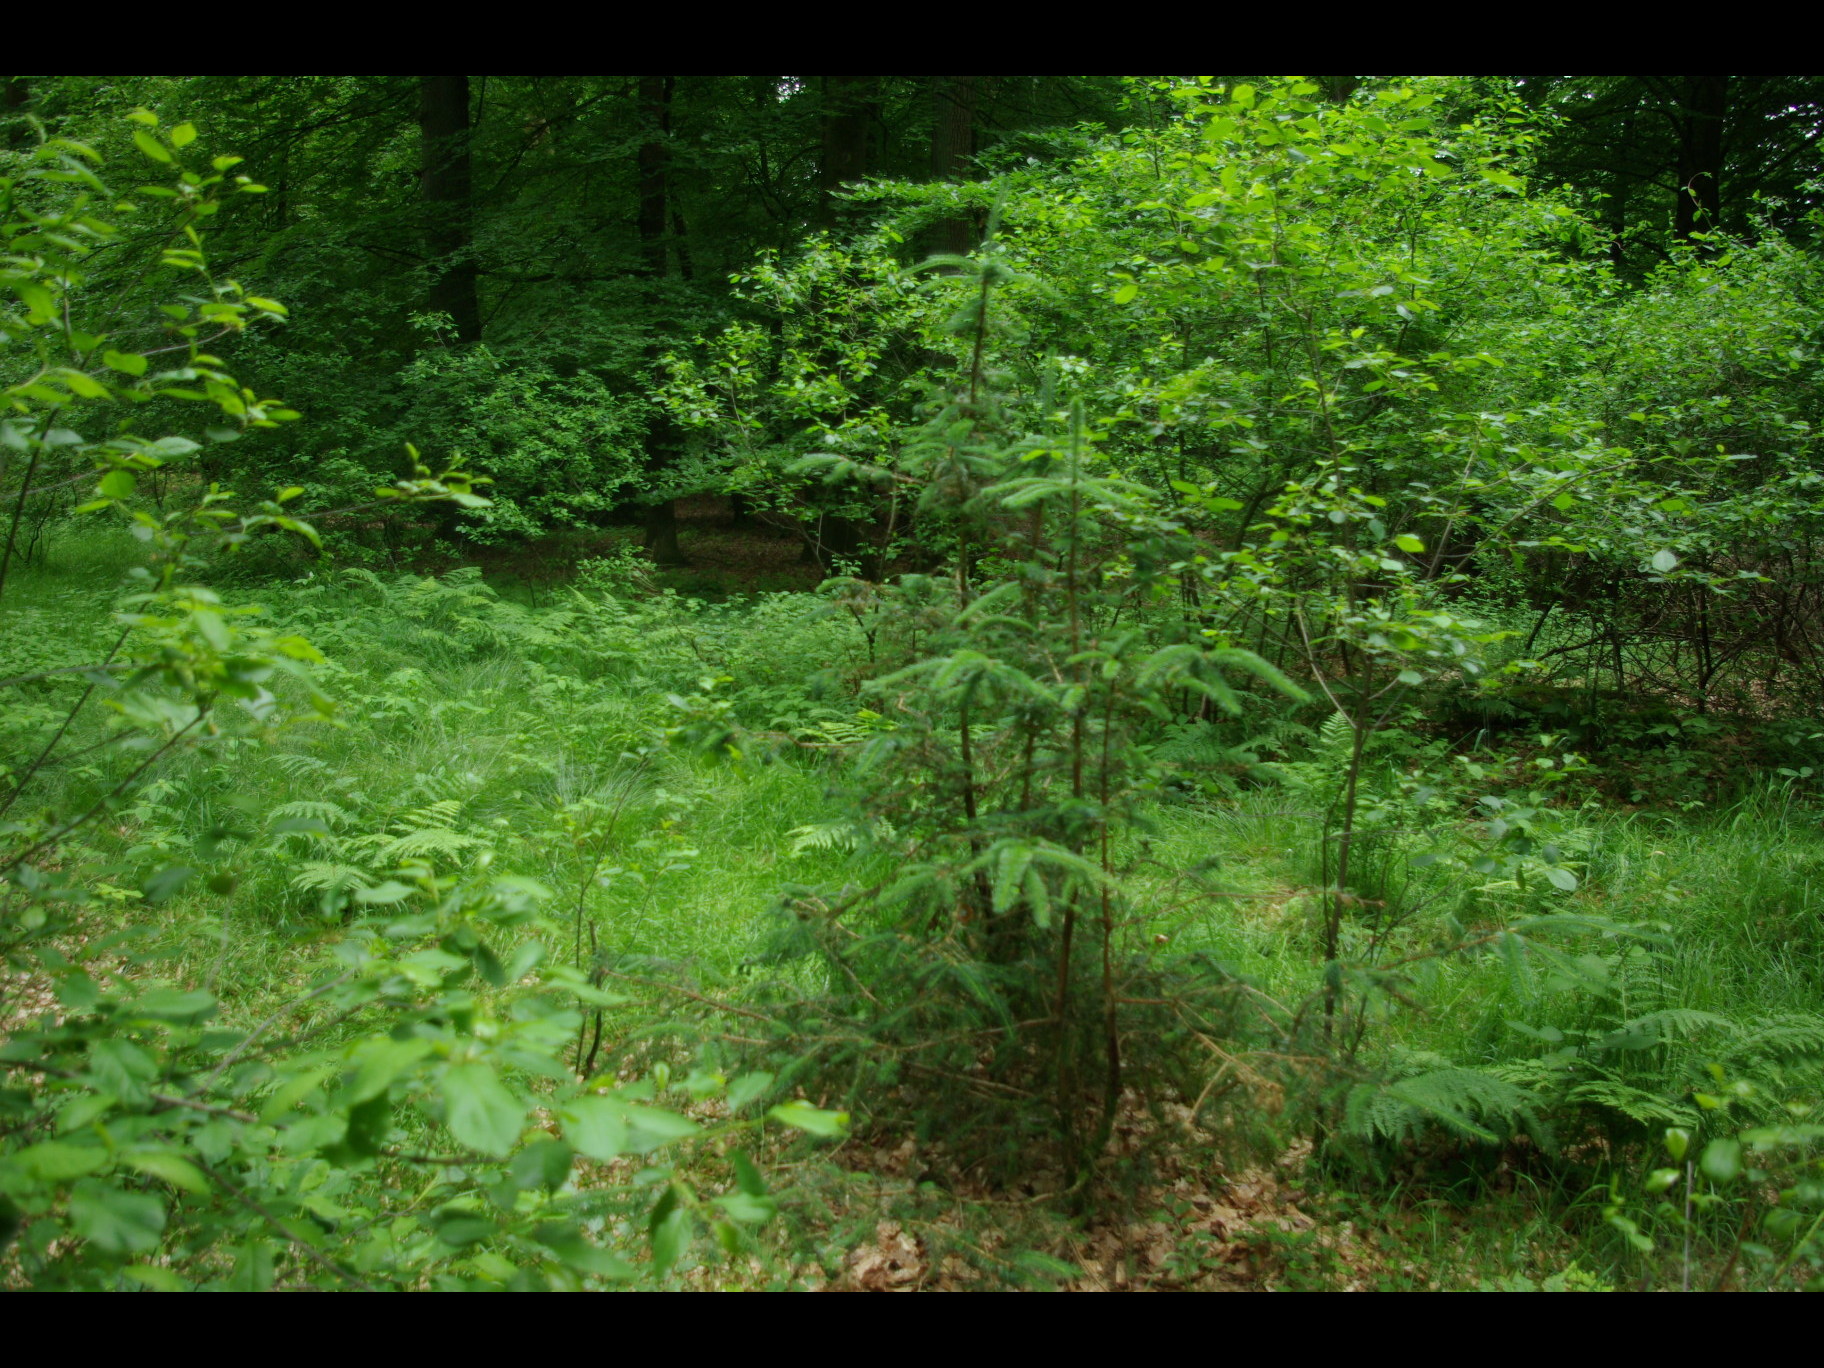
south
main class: Woodland
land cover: Broadleaved woodland
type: beech forest
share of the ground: > 75 %
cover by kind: broadleaved forest trees 80 %, unconsolidated bare surface 10 %, shrubs 5 %, herbaceous plants 5 %
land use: Forestry
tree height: > 5 m
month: June
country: DE
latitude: 54.0664
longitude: 9.6488
